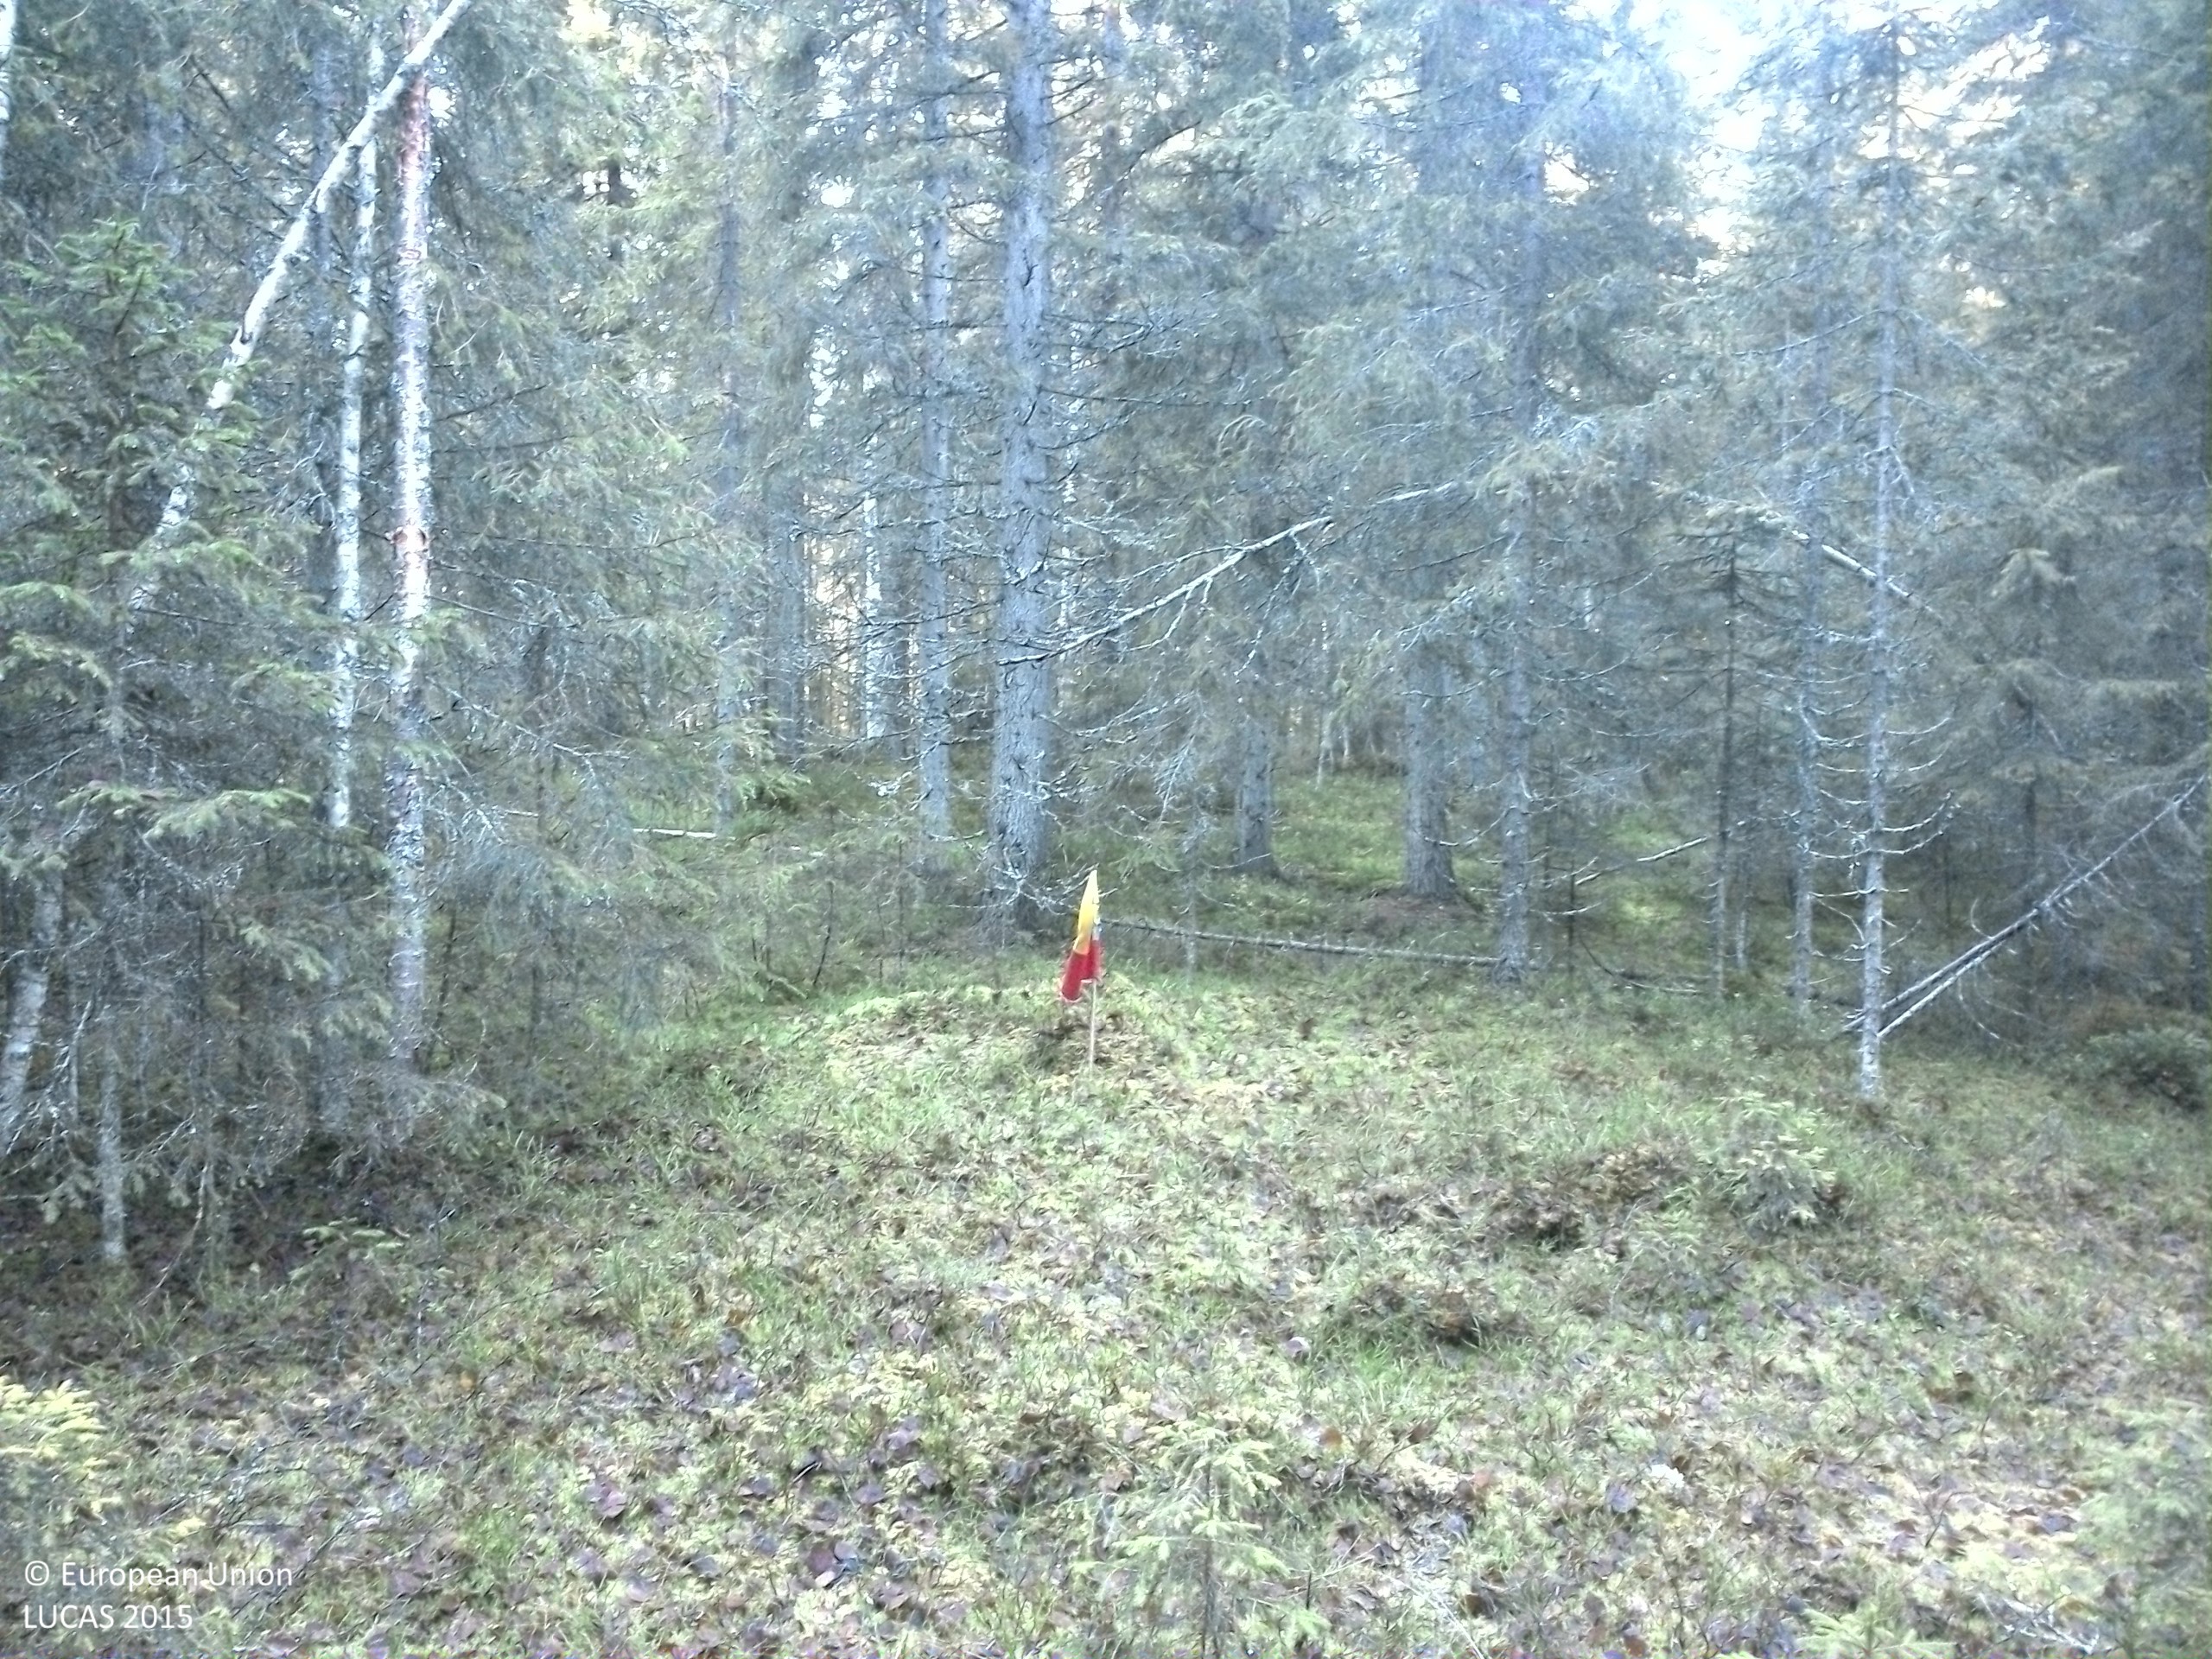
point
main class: Woodland
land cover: Spruce dominated mixed woodland
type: boreal forest
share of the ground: 50 - 75 %
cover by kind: coniferous forest trees 45 %, lichens and mosses 25 %, broadleaved forest trees 15 %, shrubs 15 %
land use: Forestry
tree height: > 5 m
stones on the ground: 25 - 50 %
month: October
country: SE
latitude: 63.8675
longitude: 16.0161
